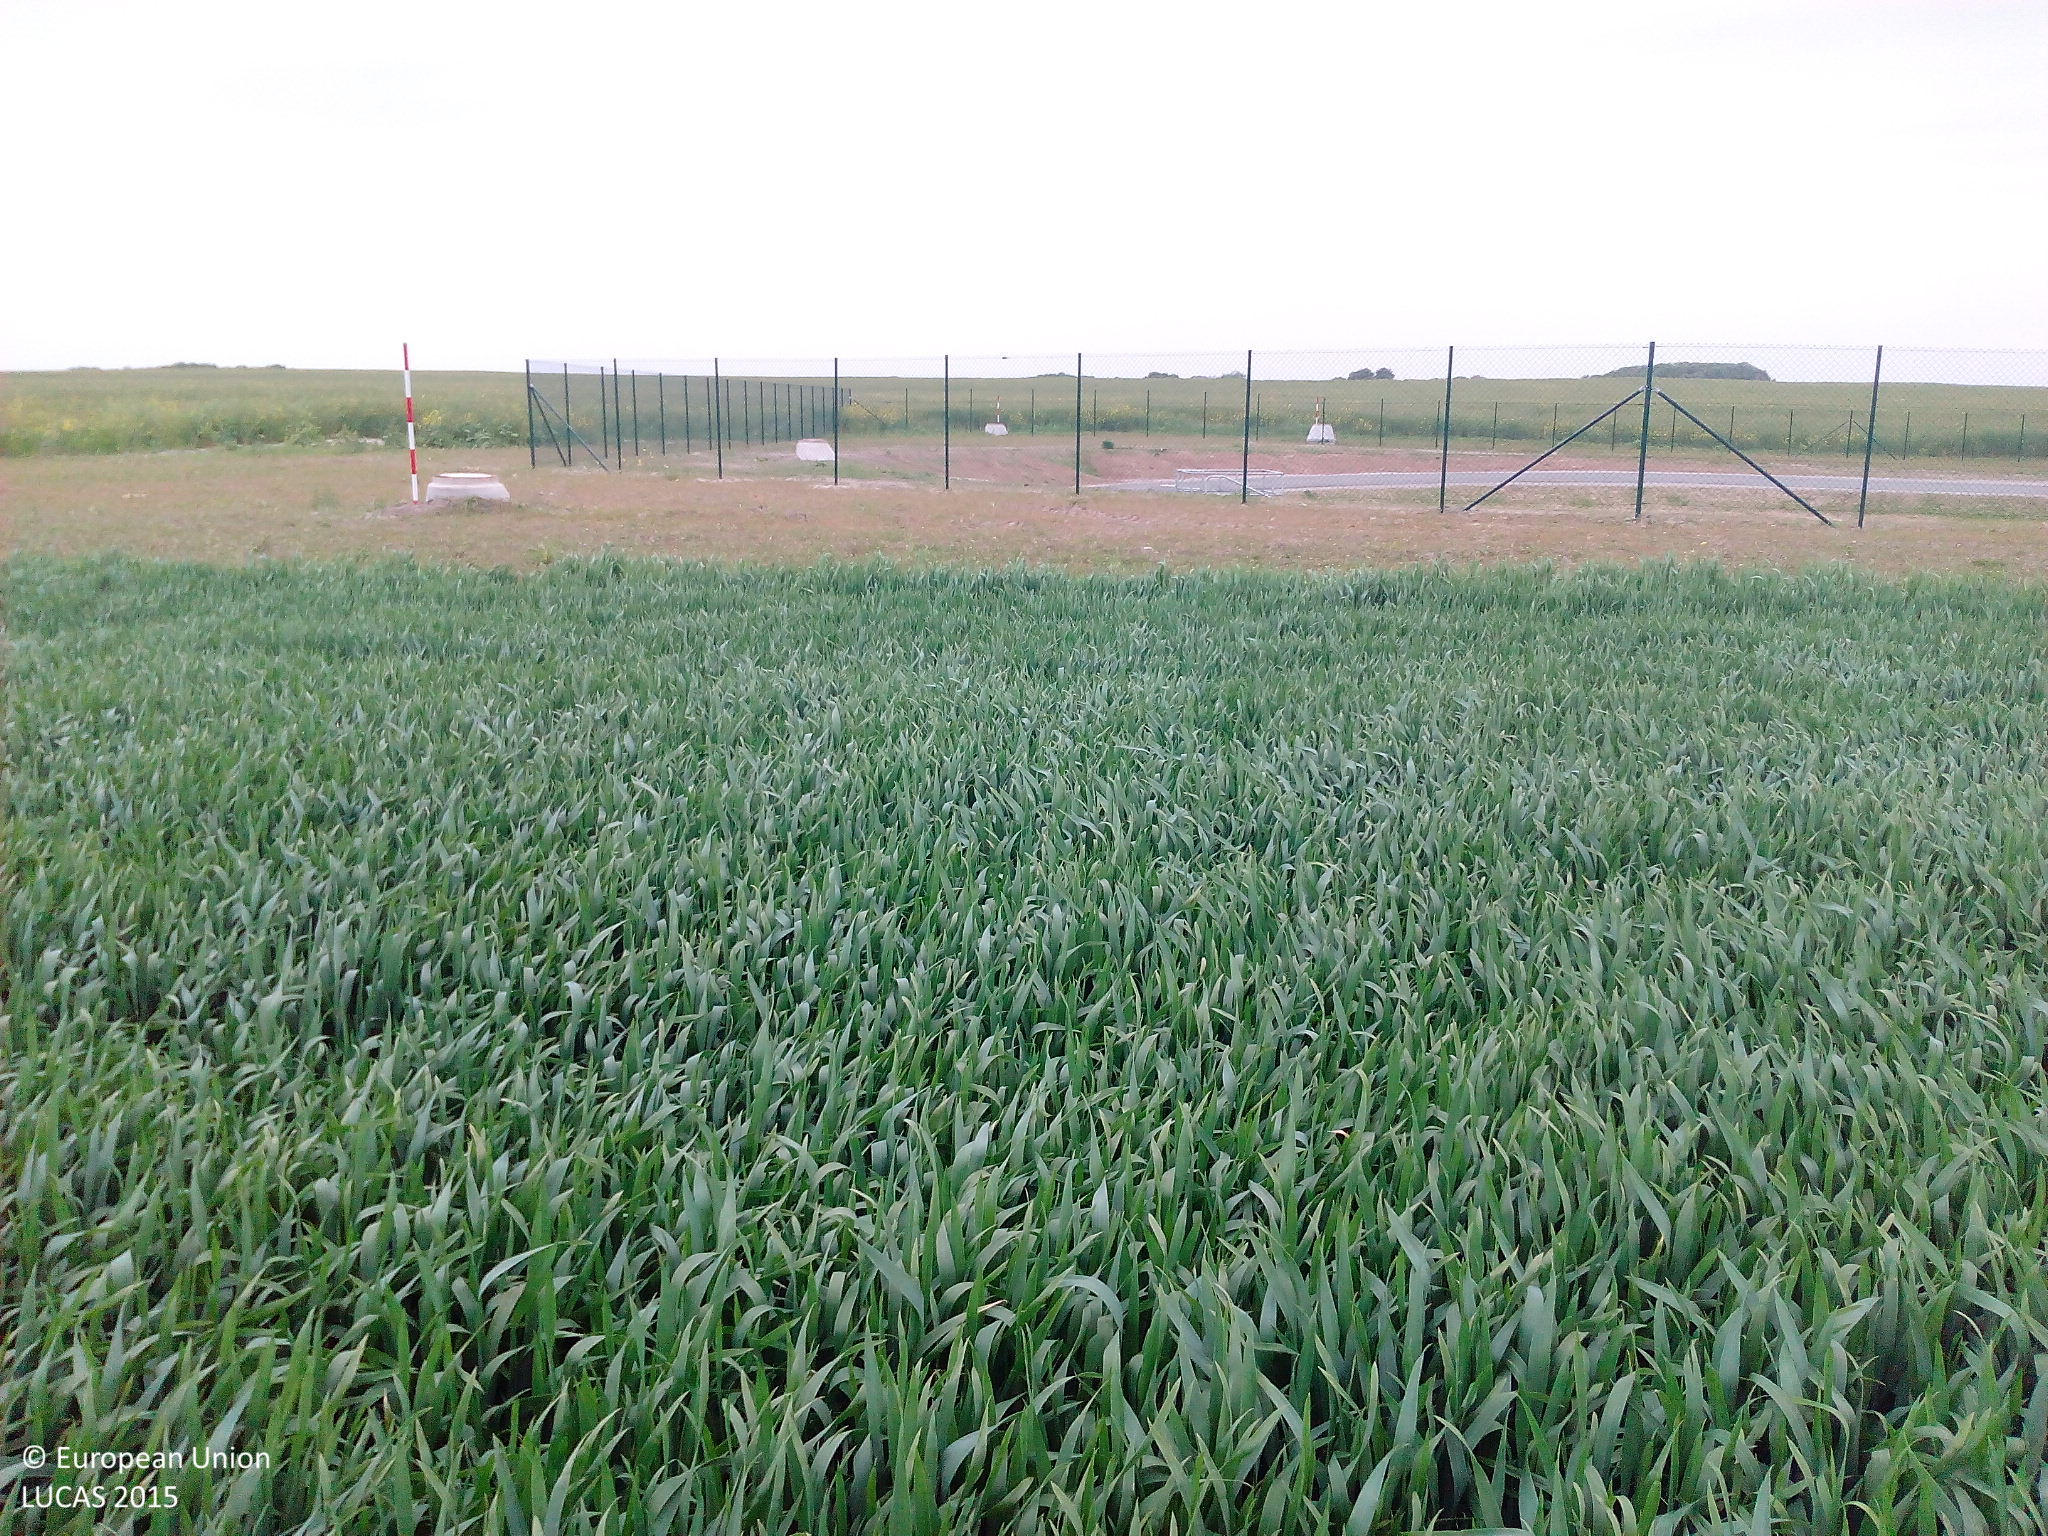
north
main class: Cropland
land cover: Common wheat
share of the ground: > 75 %
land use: Agriculture (excluding fallow land and kitchen gardens)
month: June
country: DE
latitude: 54.3642
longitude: 13.3081
